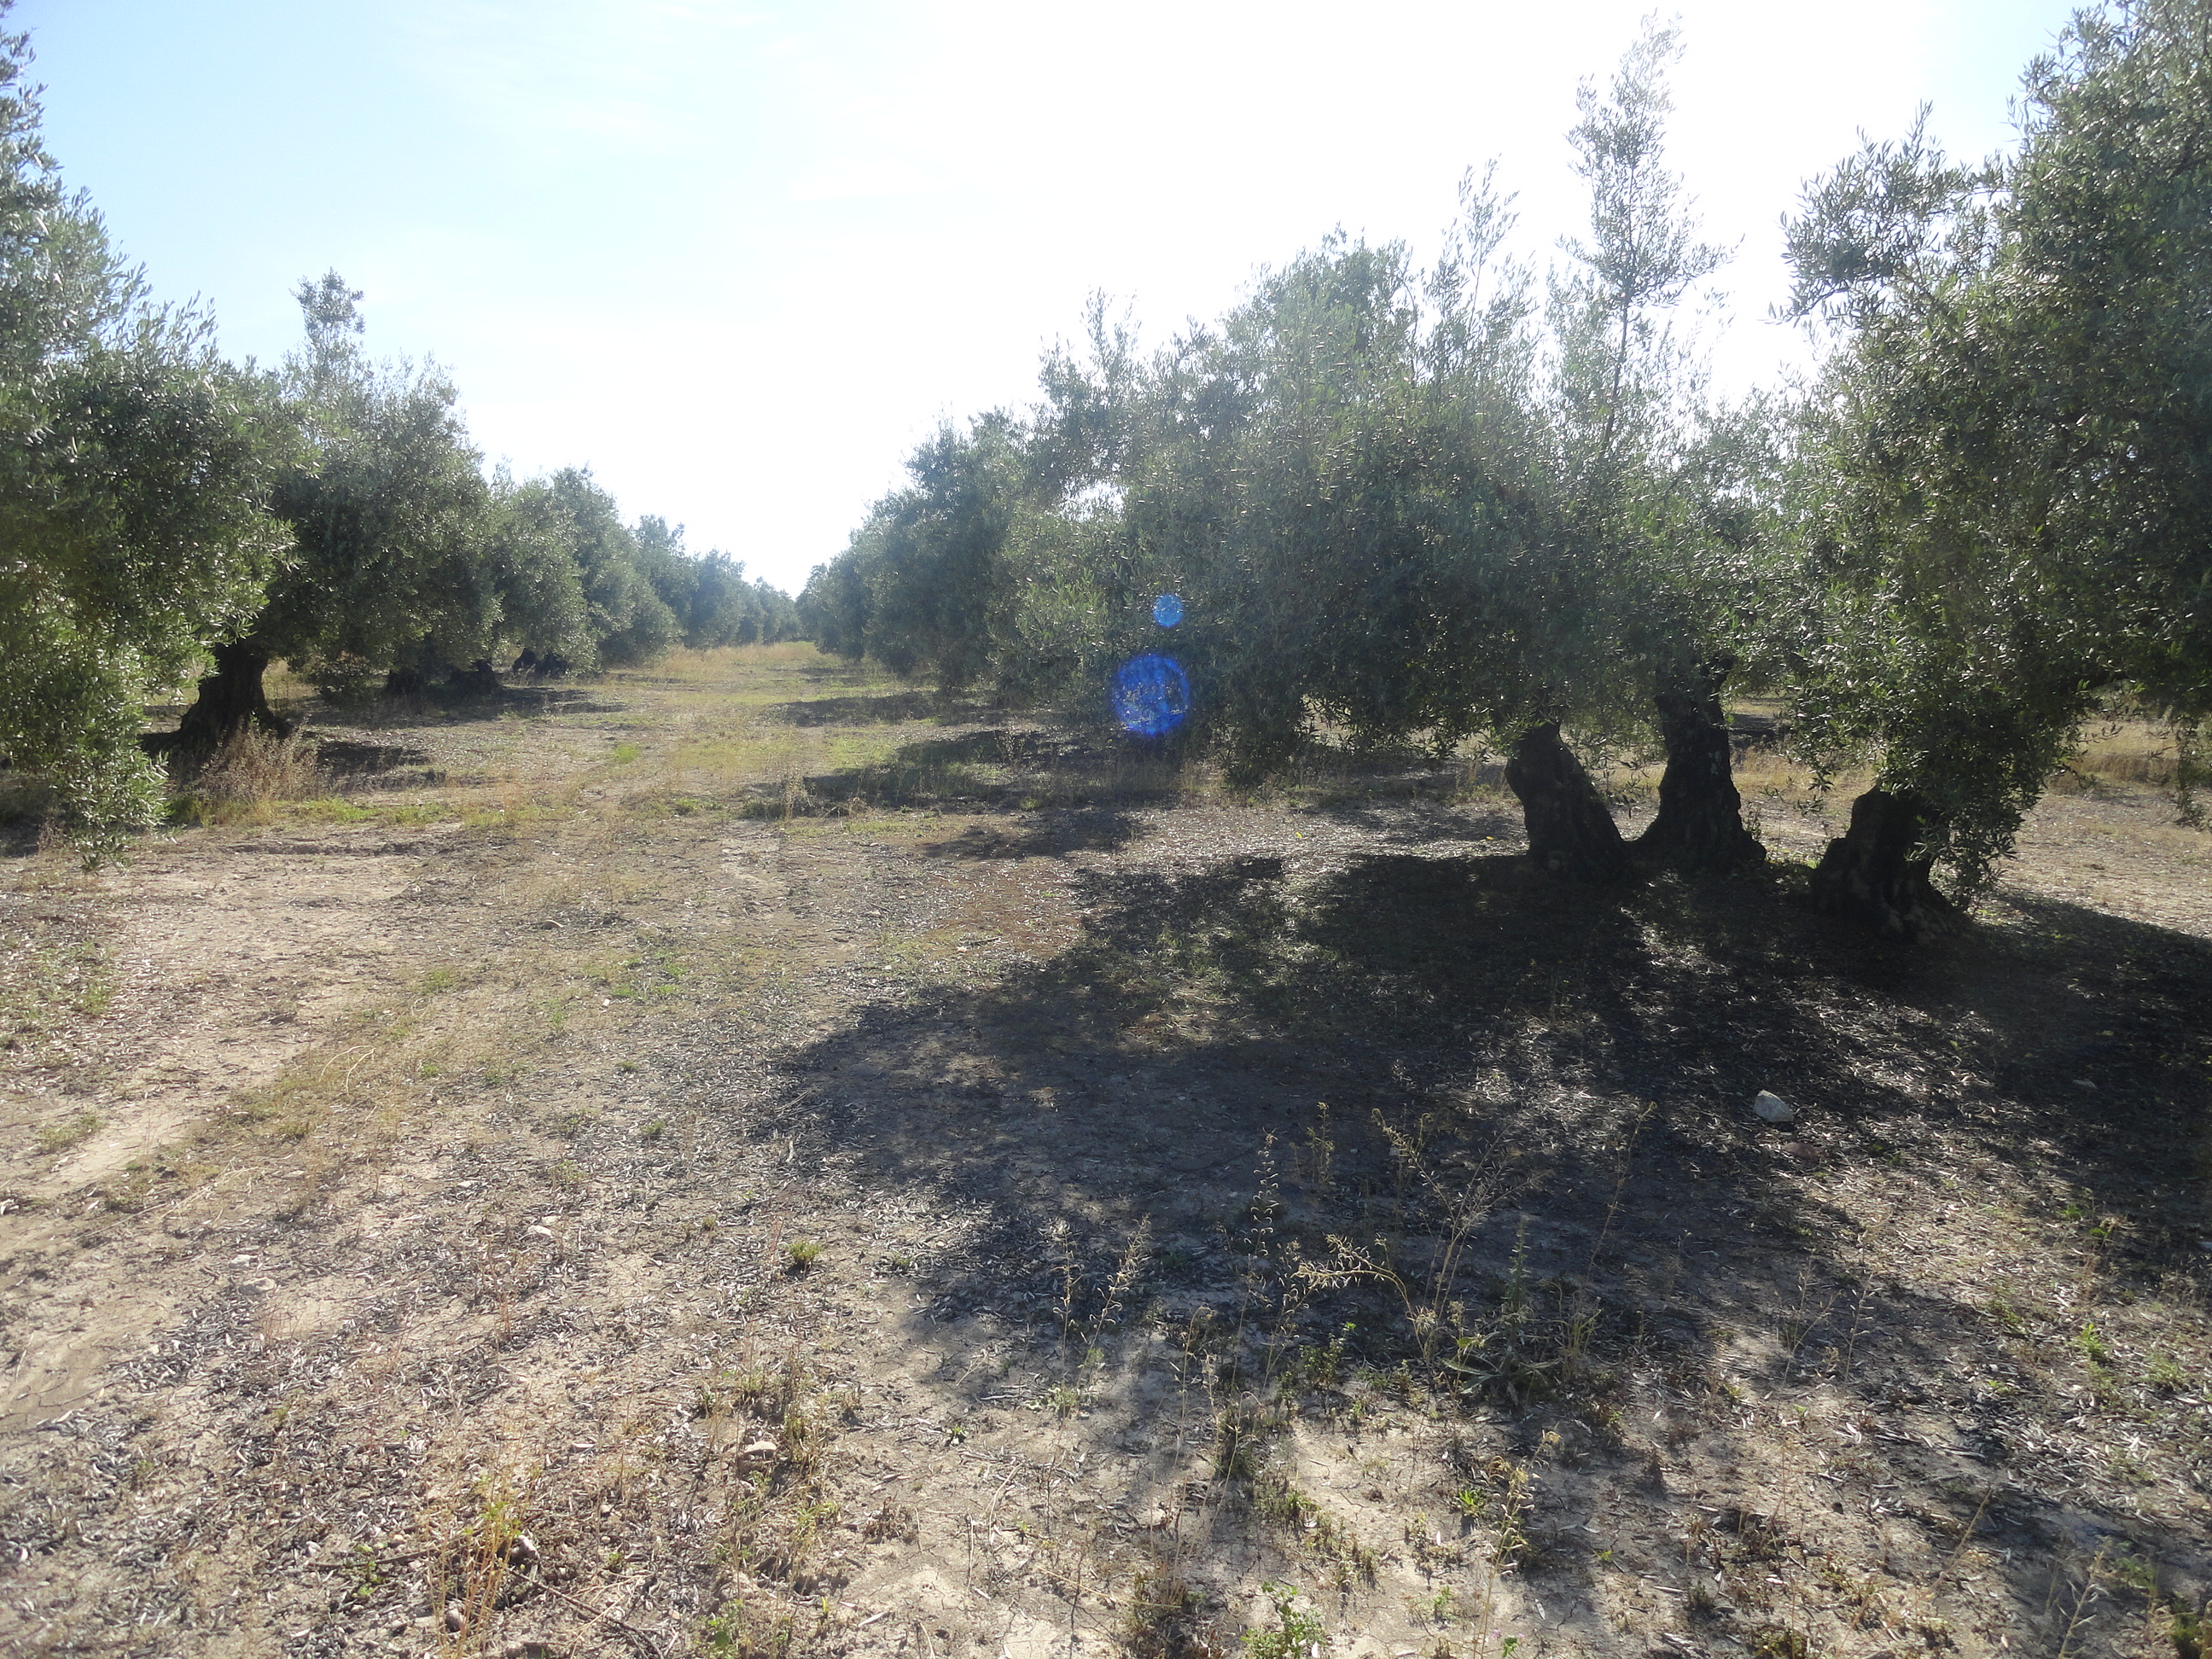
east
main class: Cropland
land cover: Olive groves
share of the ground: 50 - 75 %
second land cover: Spontaneously vegetated surfaces
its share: 25 - 50 %
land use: Agriculture (excluding fallow land and kitchen gardens)
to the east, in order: Olive groves; Spontaneously vegetated surfaces; Tracks; Olive groves
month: April
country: ES
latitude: 37.6408
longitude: -4.5014
